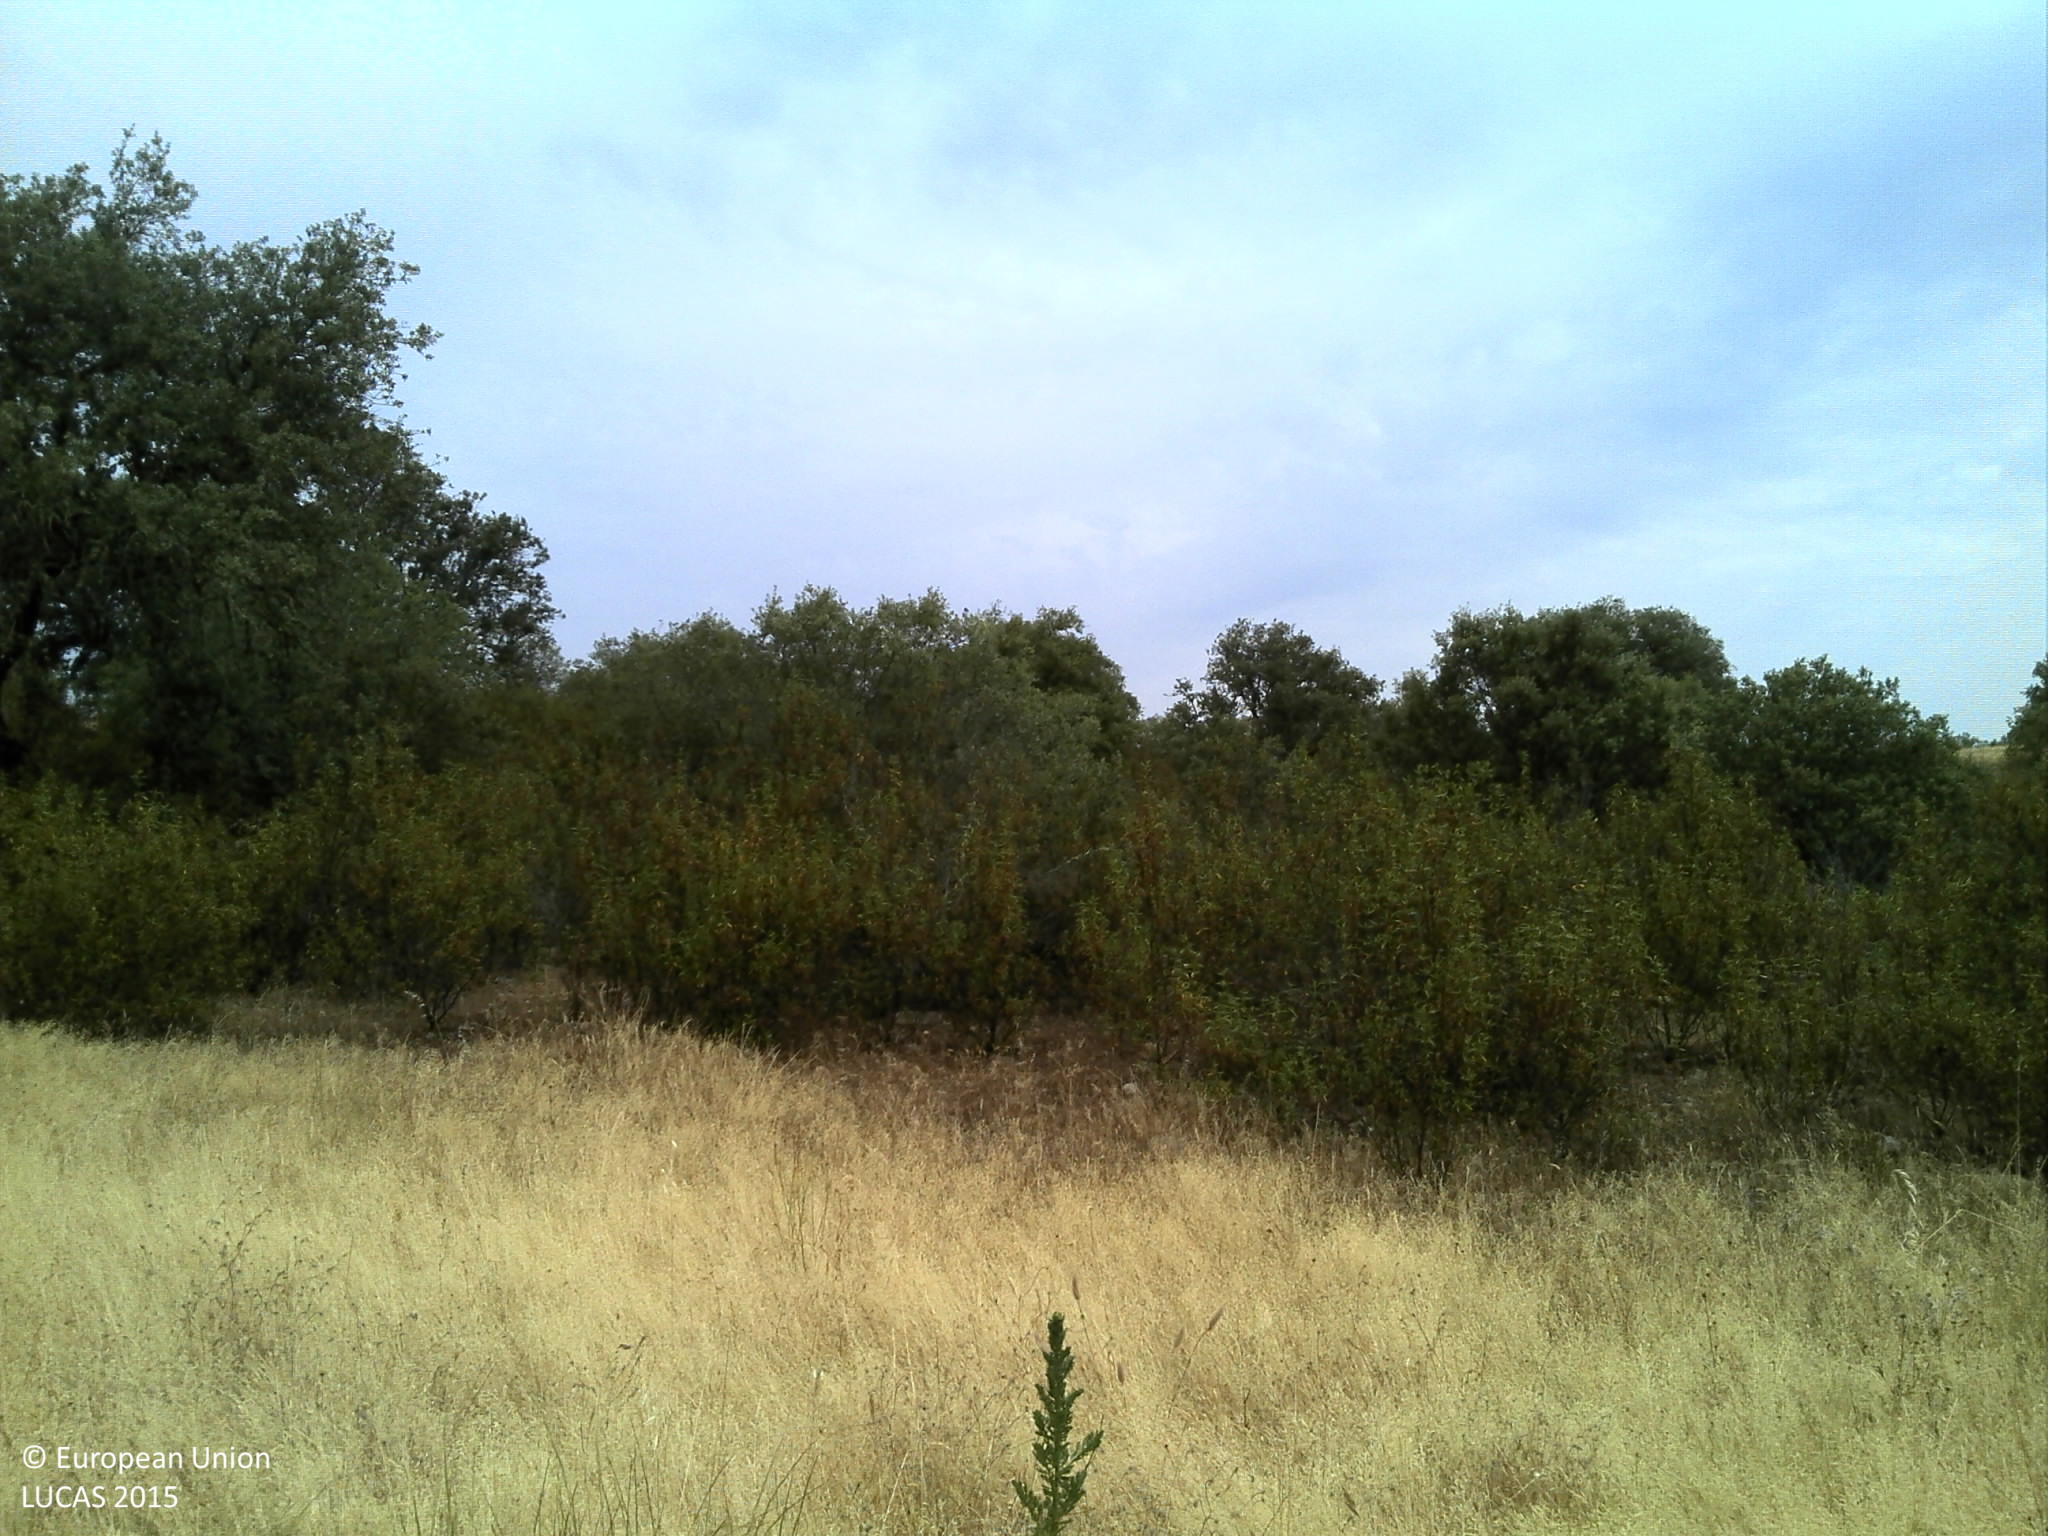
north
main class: Woodland
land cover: Broadleaved woodland
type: broadleaved evergreen forest
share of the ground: 10 - 25 %
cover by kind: shrubs 30 %, herbaceous plants 30 %, broadleaved forest trees 20 %, unconsolidated bare surface 20 %
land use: Forestry
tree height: > 5 m
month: June
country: PT
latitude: 38.5665
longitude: -7.8150
